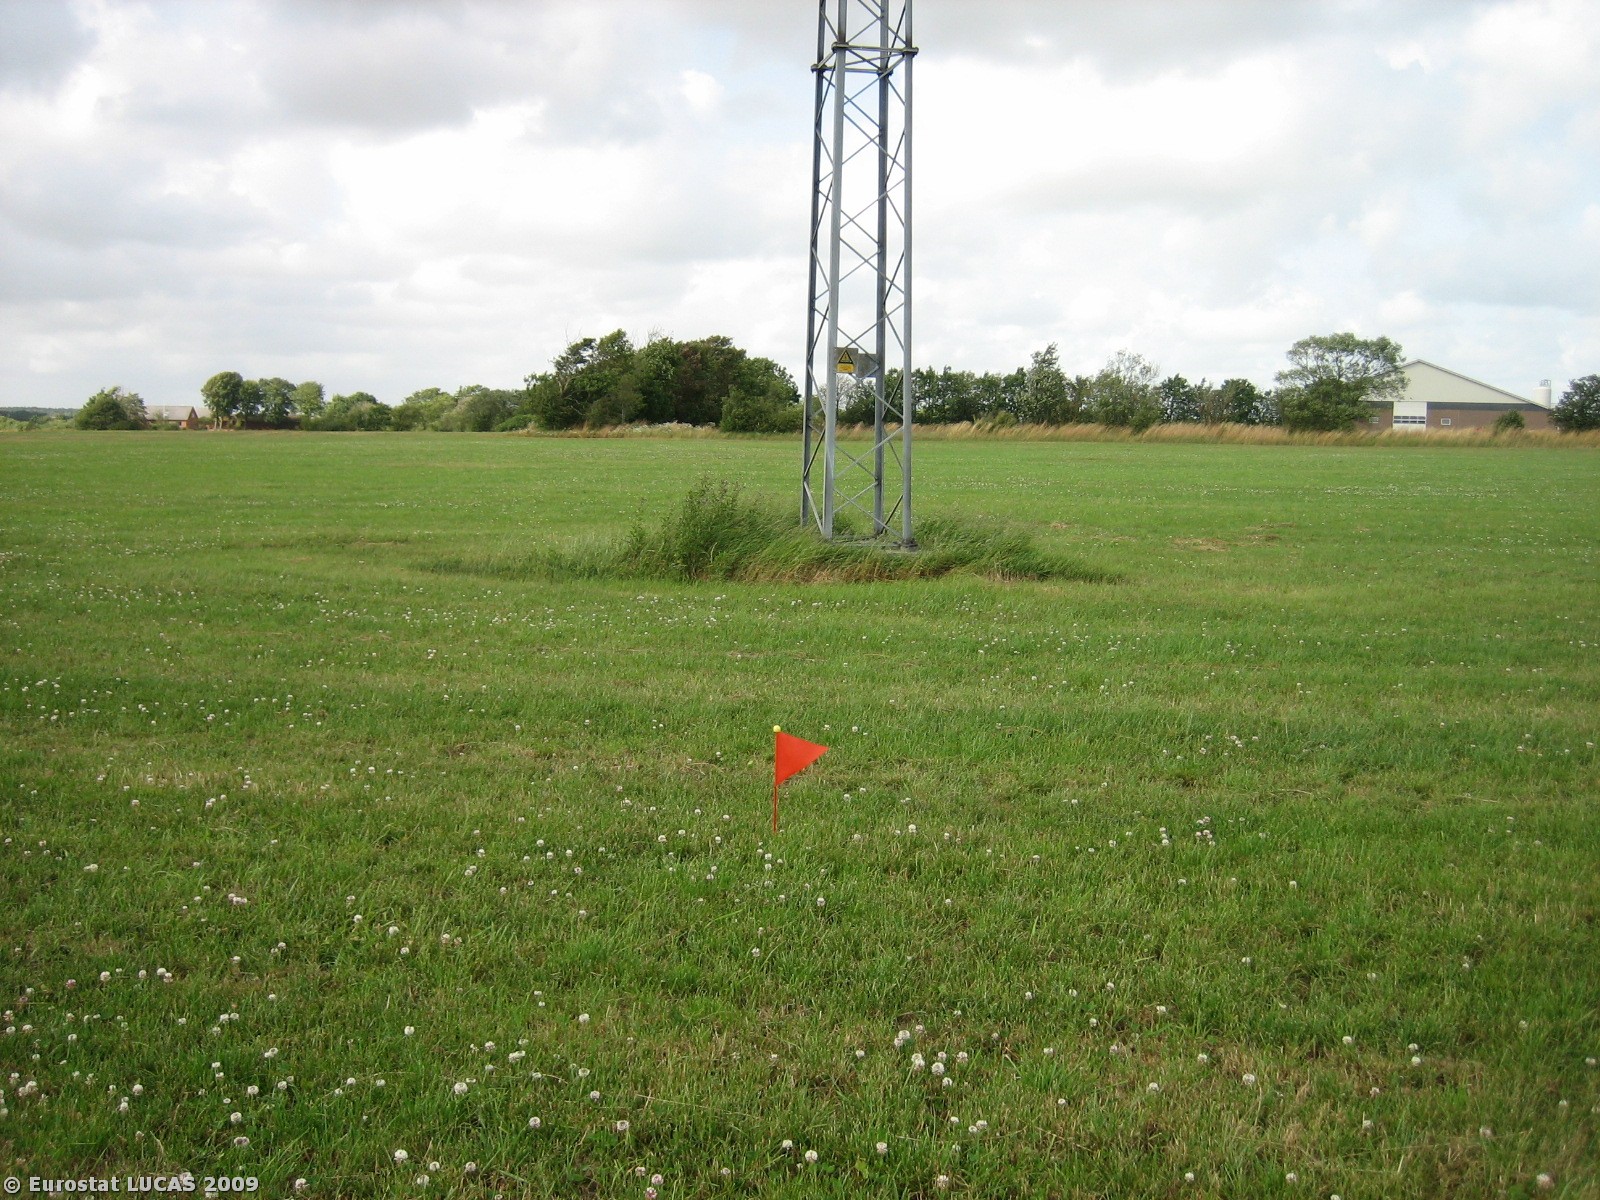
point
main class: Cropland
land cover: Temporary grasslands
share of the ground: > 75 %
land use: Agriculture (excluding fallow land and kitchen gardens)
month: July
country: DK
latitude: 55.7298
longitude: 8.5205
